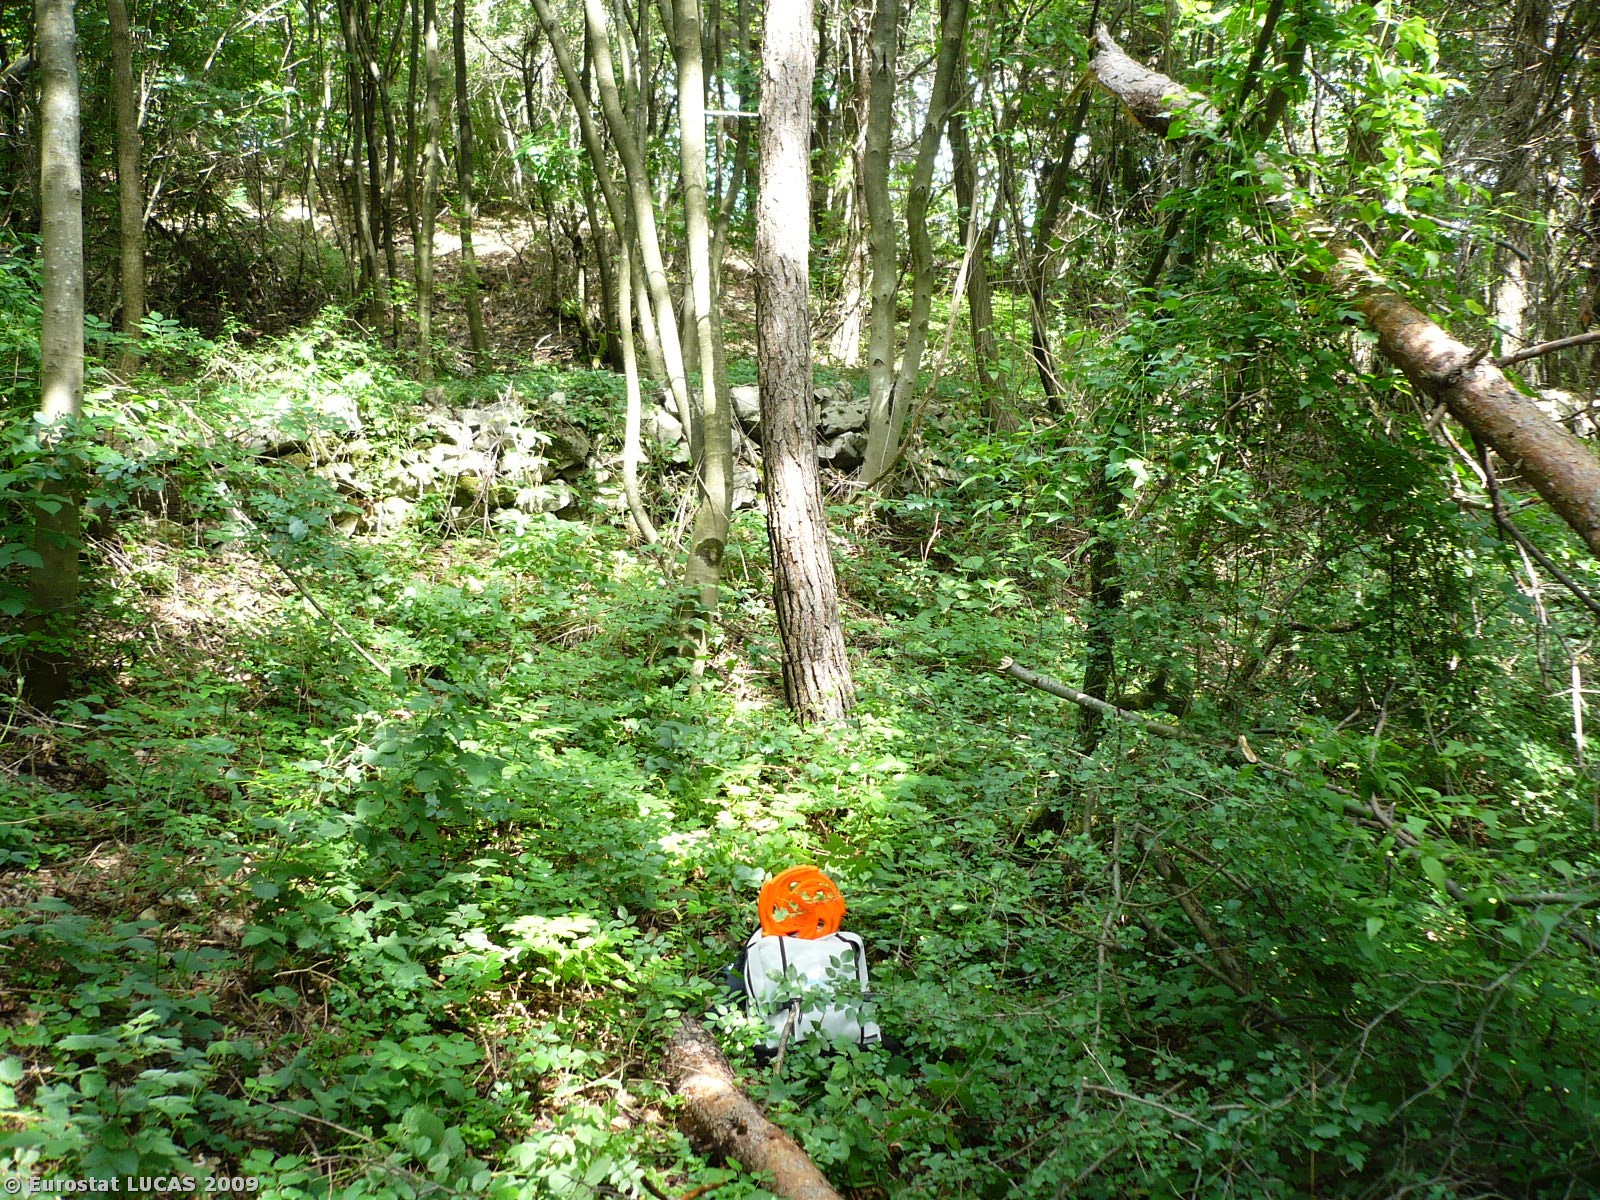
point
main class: Woodland
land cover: Broadleaved woodland
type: thermophilous deciduous forest
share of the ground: > 75 %
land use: Unused
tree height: > 5 m
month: June
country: SI
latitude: 46.0364
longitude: 13.6529
